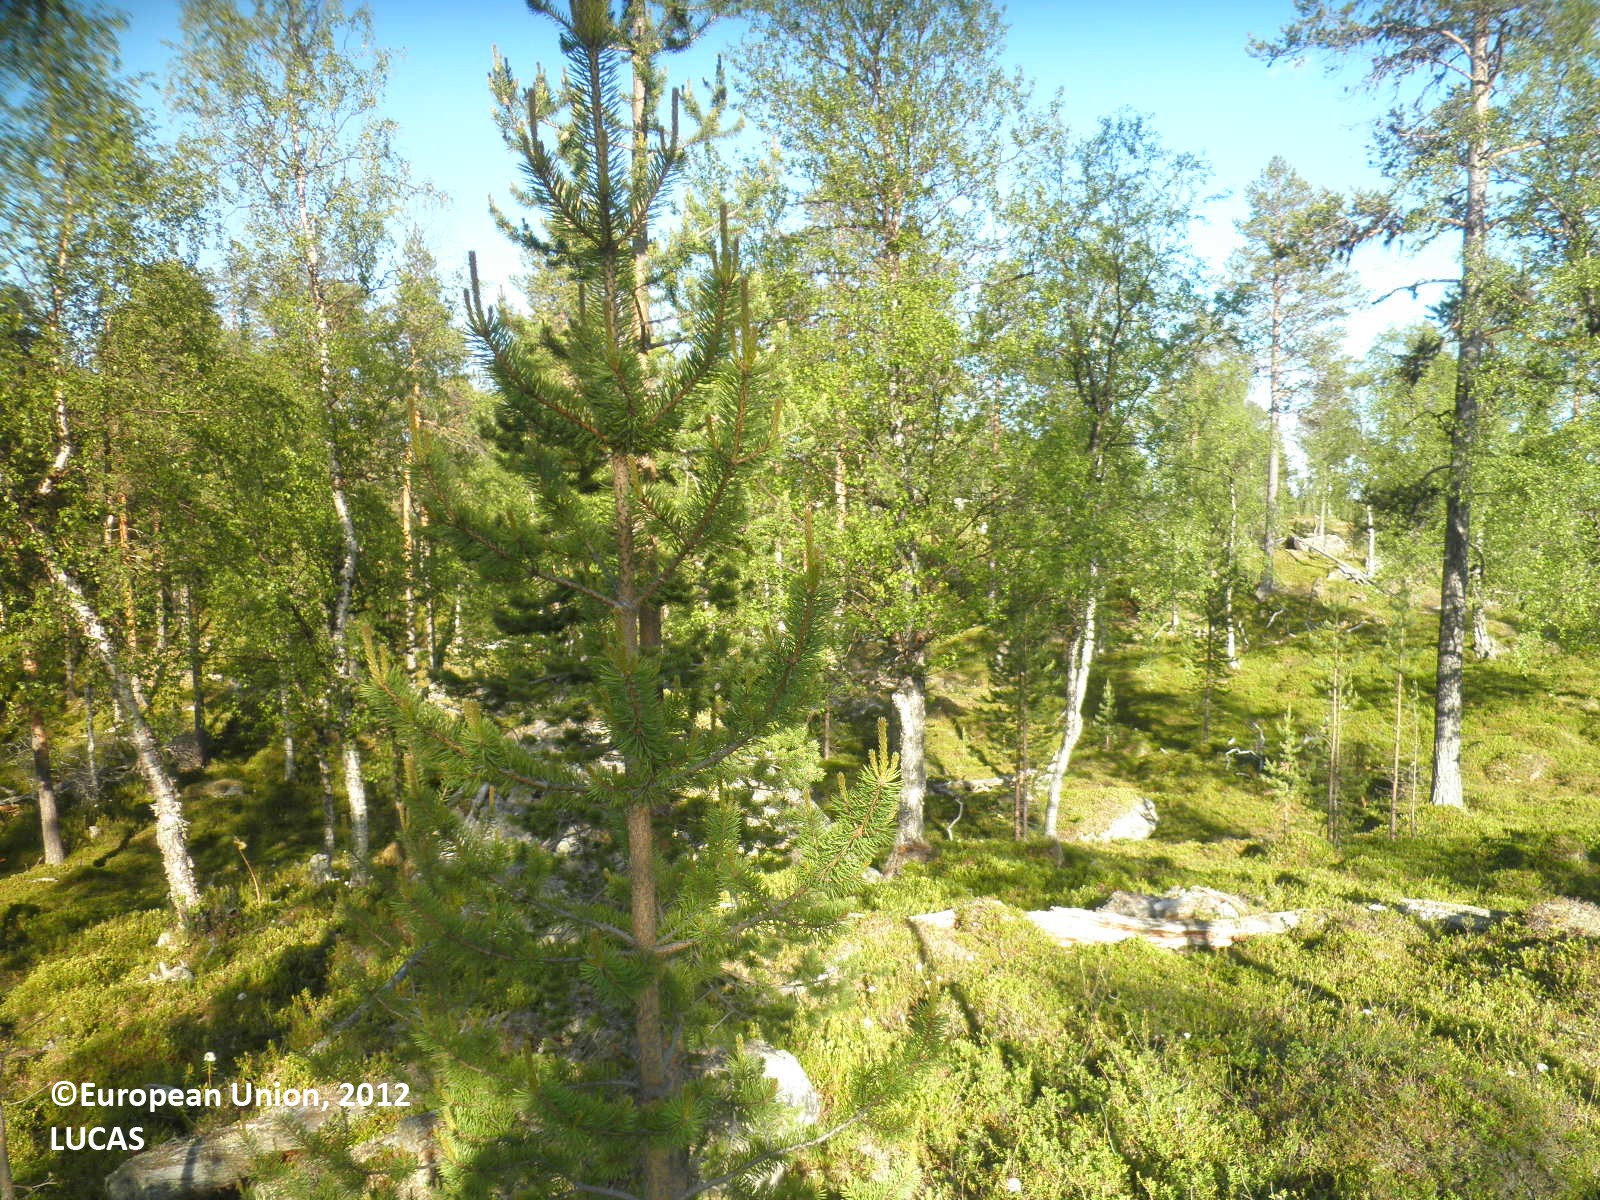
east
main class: Woodland
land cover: Pine dominated mixed woodland
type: boreal forest
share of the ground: 25 - 50 %
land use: Forestry
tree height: > 5 m
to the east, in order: Pine dominated mixed woodland; Pine dominated coniferous woodland
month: July
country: FI
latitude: 68.8534
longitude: 27.2295
